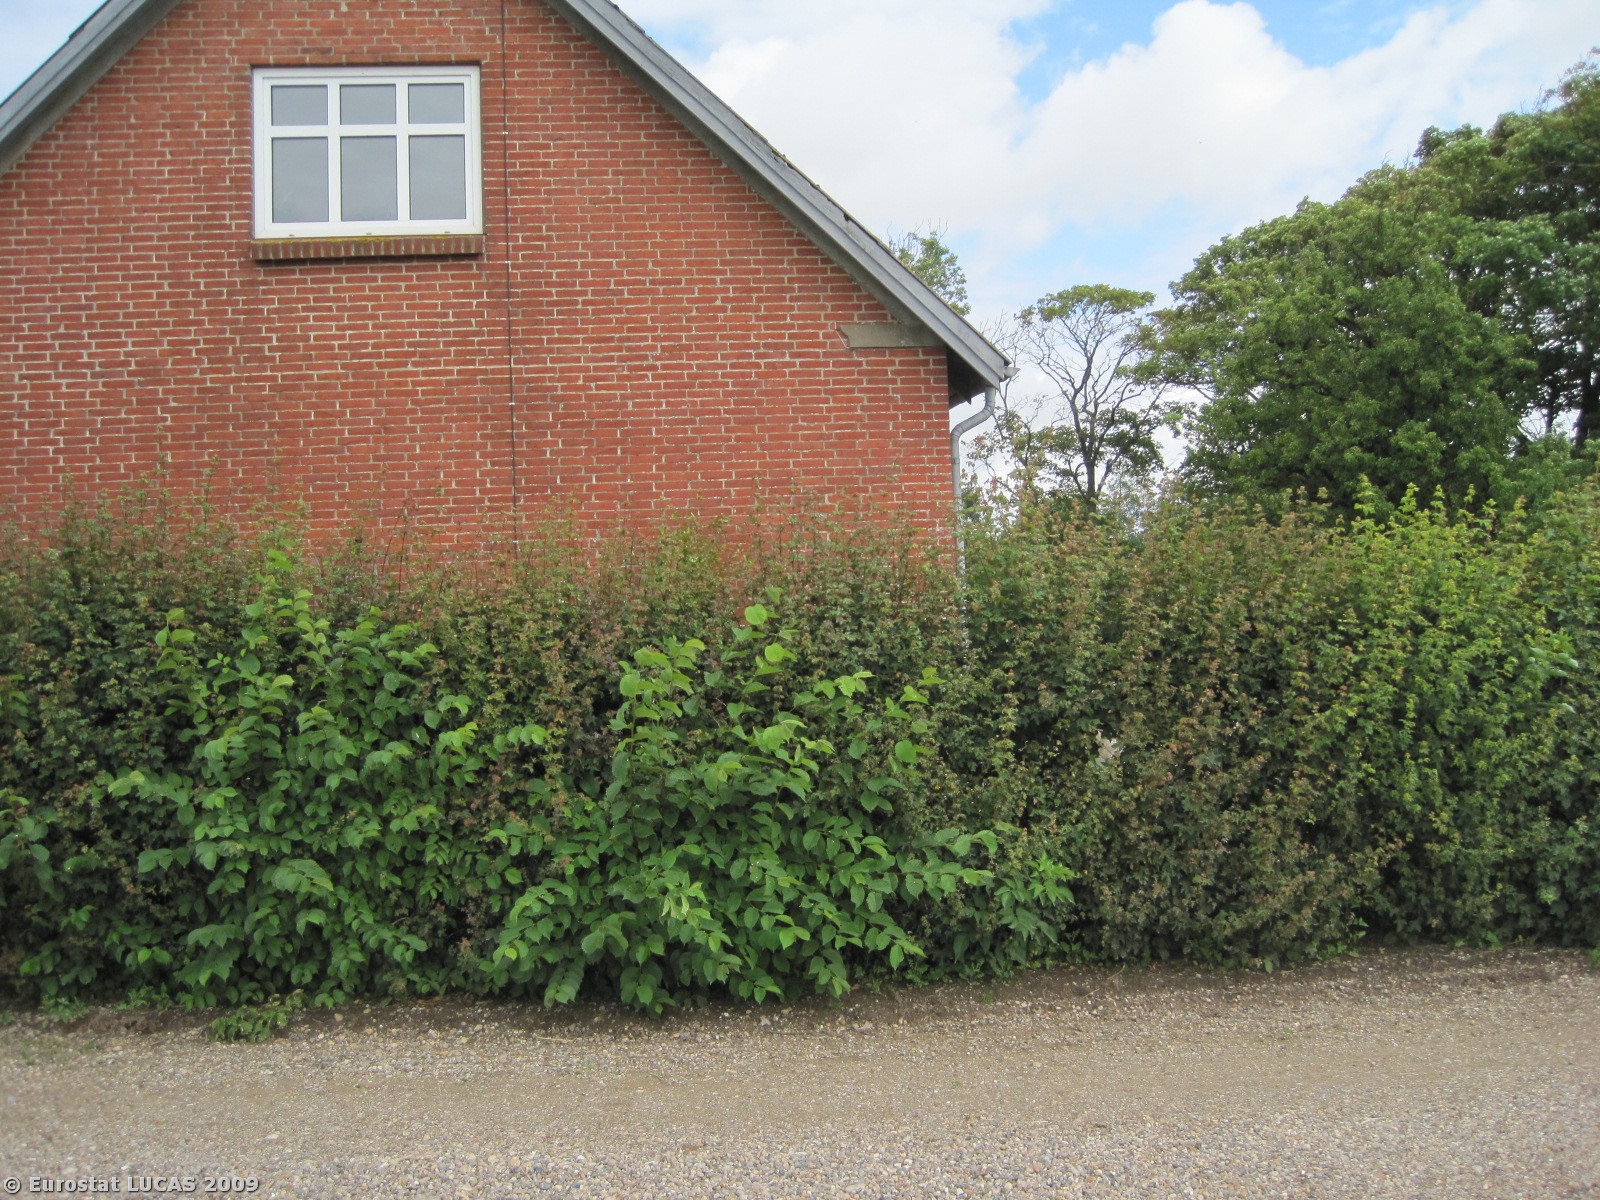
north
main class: Cropland
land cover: Common wheat
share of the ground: > 75 %
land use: Agriculture (excluding fallow land and kitchen gardens)
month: July
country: DK
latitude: 56.4157
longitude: 8.7858
